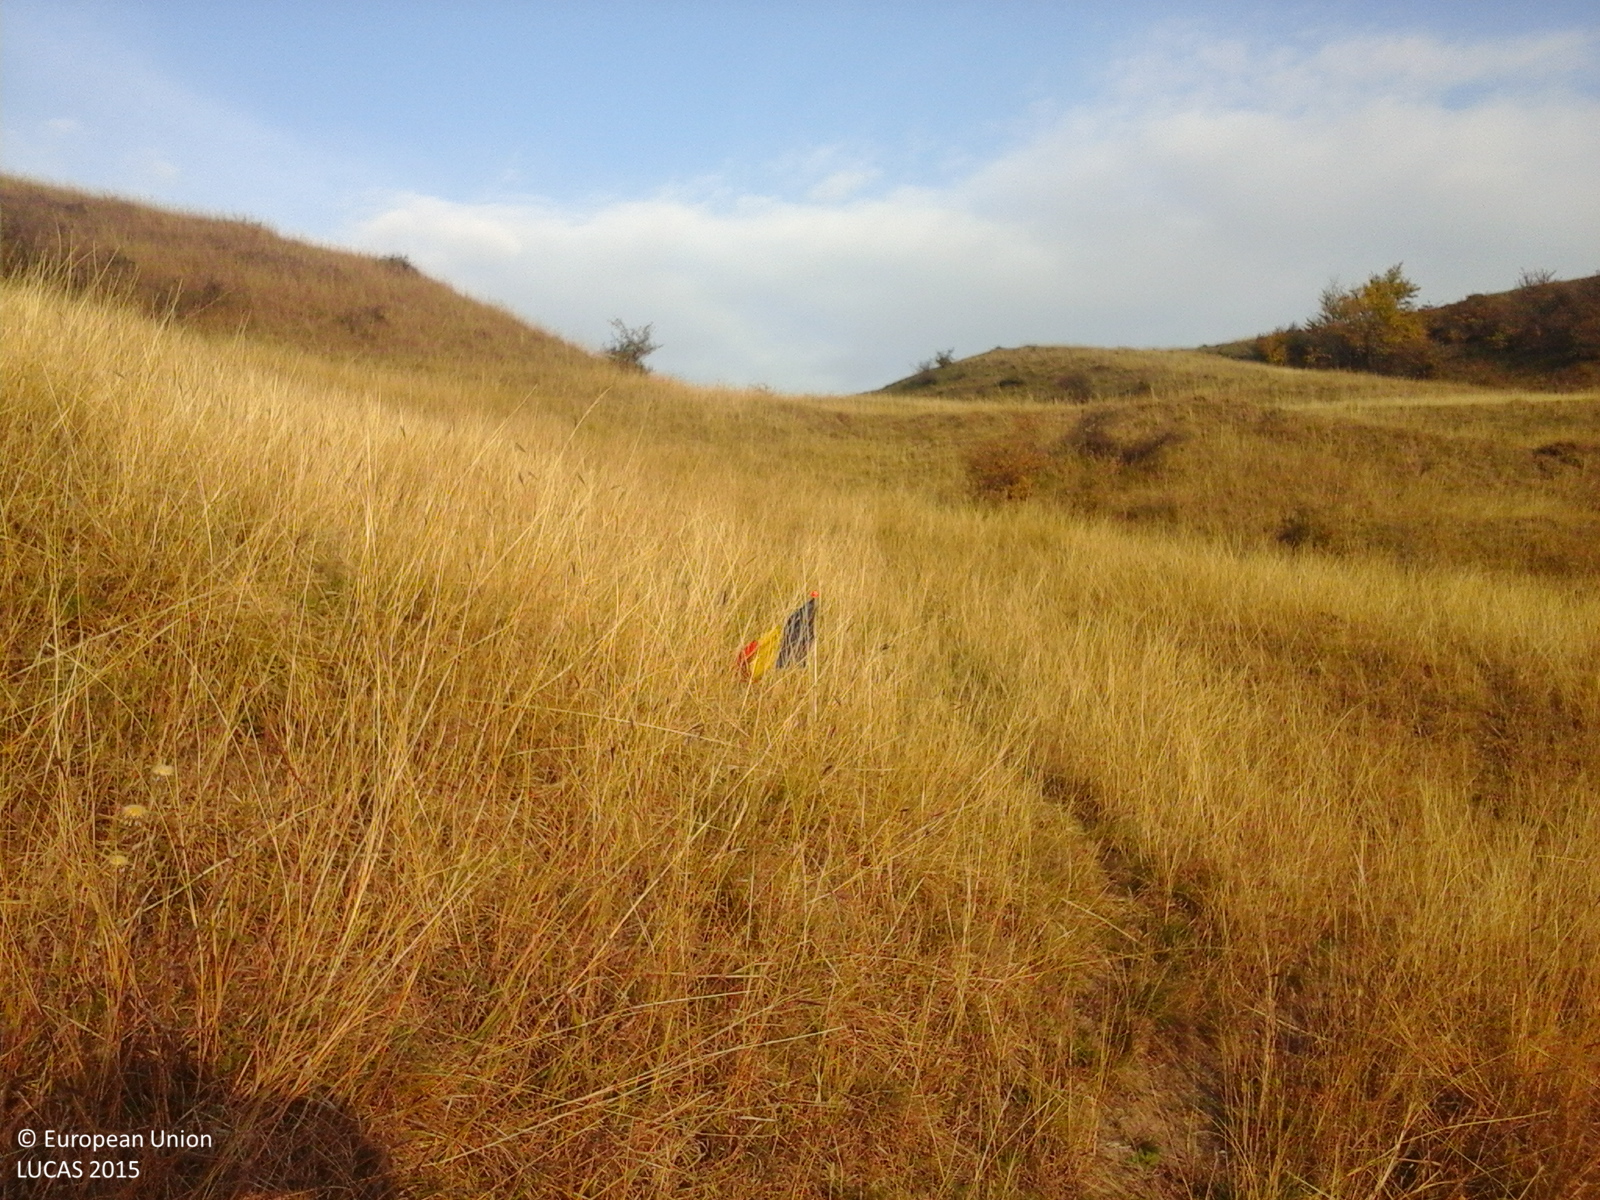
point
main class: Grassland
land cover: Grassland without tree/shrub cover
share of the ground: > 75 %
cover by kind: herbaceous plants 100 %
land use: Agriculture (excluding fallow land and kitchen gardens)
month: October
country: RO
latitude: 45.4319
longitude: 26.5777
